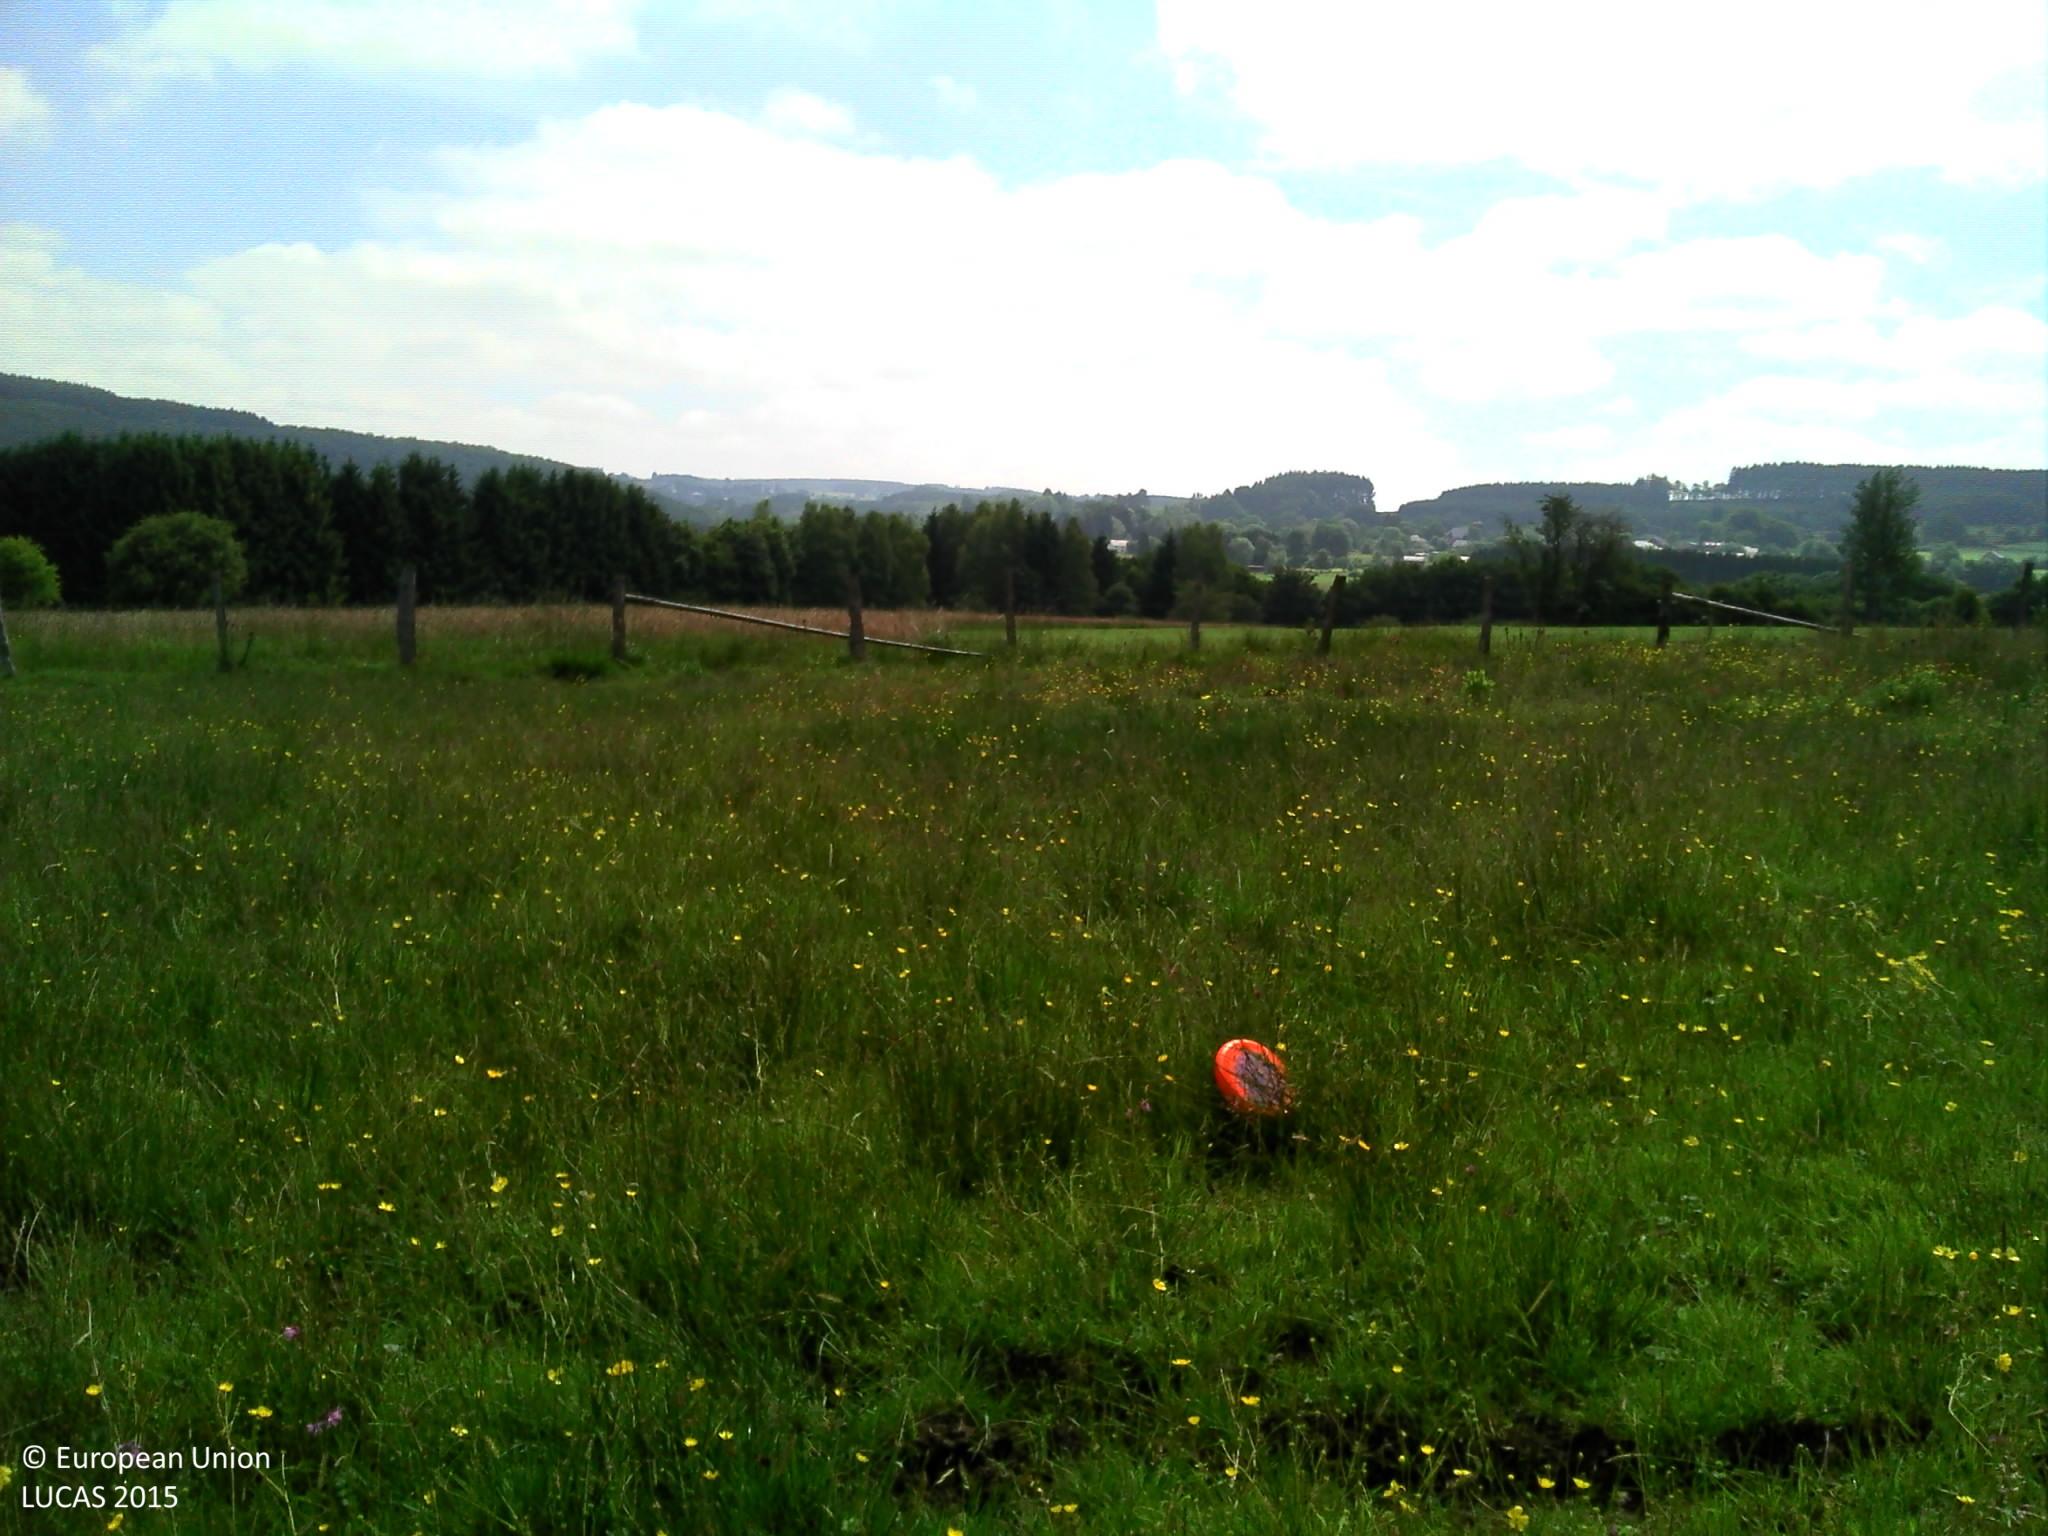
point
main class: Grassland
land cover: Grassland without tree/shrub cover
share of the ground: > 75 %
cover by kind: herbaceous plants 95 %, unconsolidated bare surface 5 %
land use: Agriculture (excluding fallow land and kitchen gardens)
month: June
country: BE
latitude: 50.2628
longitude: 5.6358
